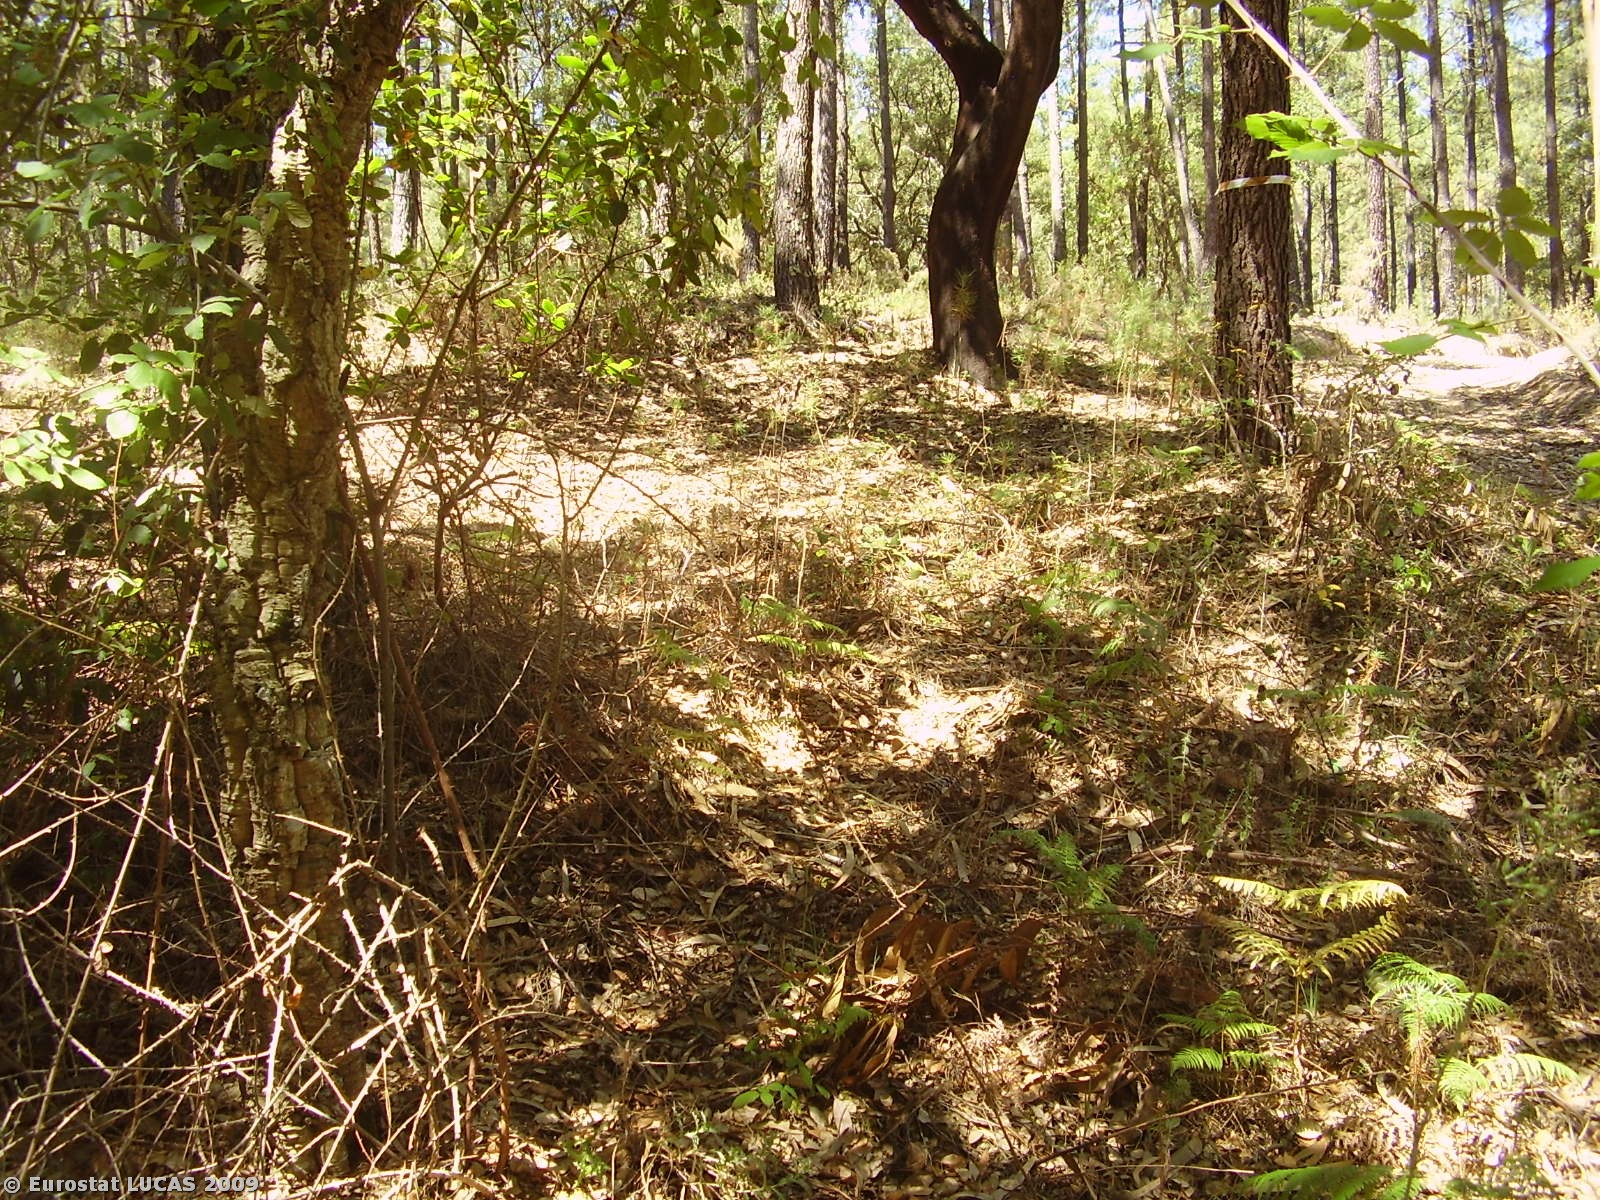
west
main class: Woodland
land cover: Broadleaved woodland
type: broadleaved evergreen forest
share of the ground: 50 - 75 %
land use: Forestry
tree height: > 5 m
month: July
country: PT
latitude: 39.4102
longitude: -8.2398
